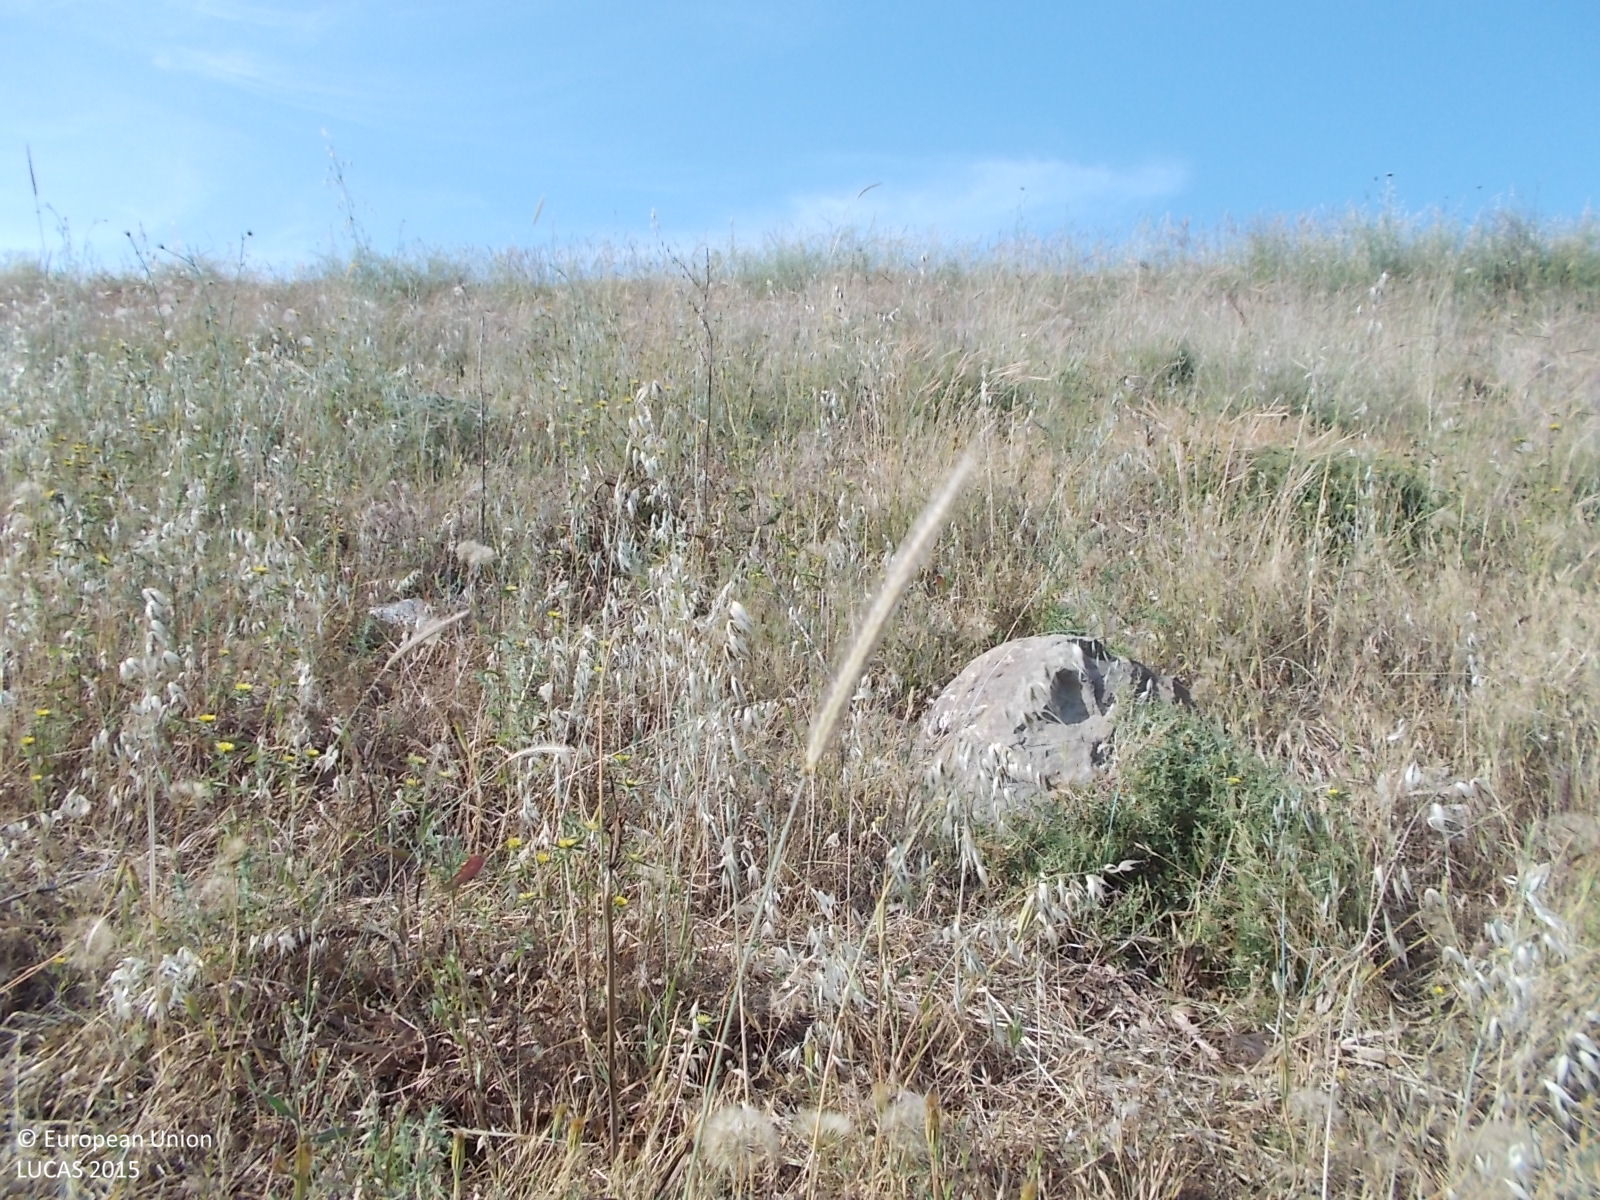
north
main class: Grassland
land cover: Grassland without tree/shrub cover
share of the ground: > 75 %
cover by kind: herbaceous plants 100 %
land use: Semi-natural and natural areas not in use
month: May
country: CY
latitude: 34.9255
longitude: 32.4039
